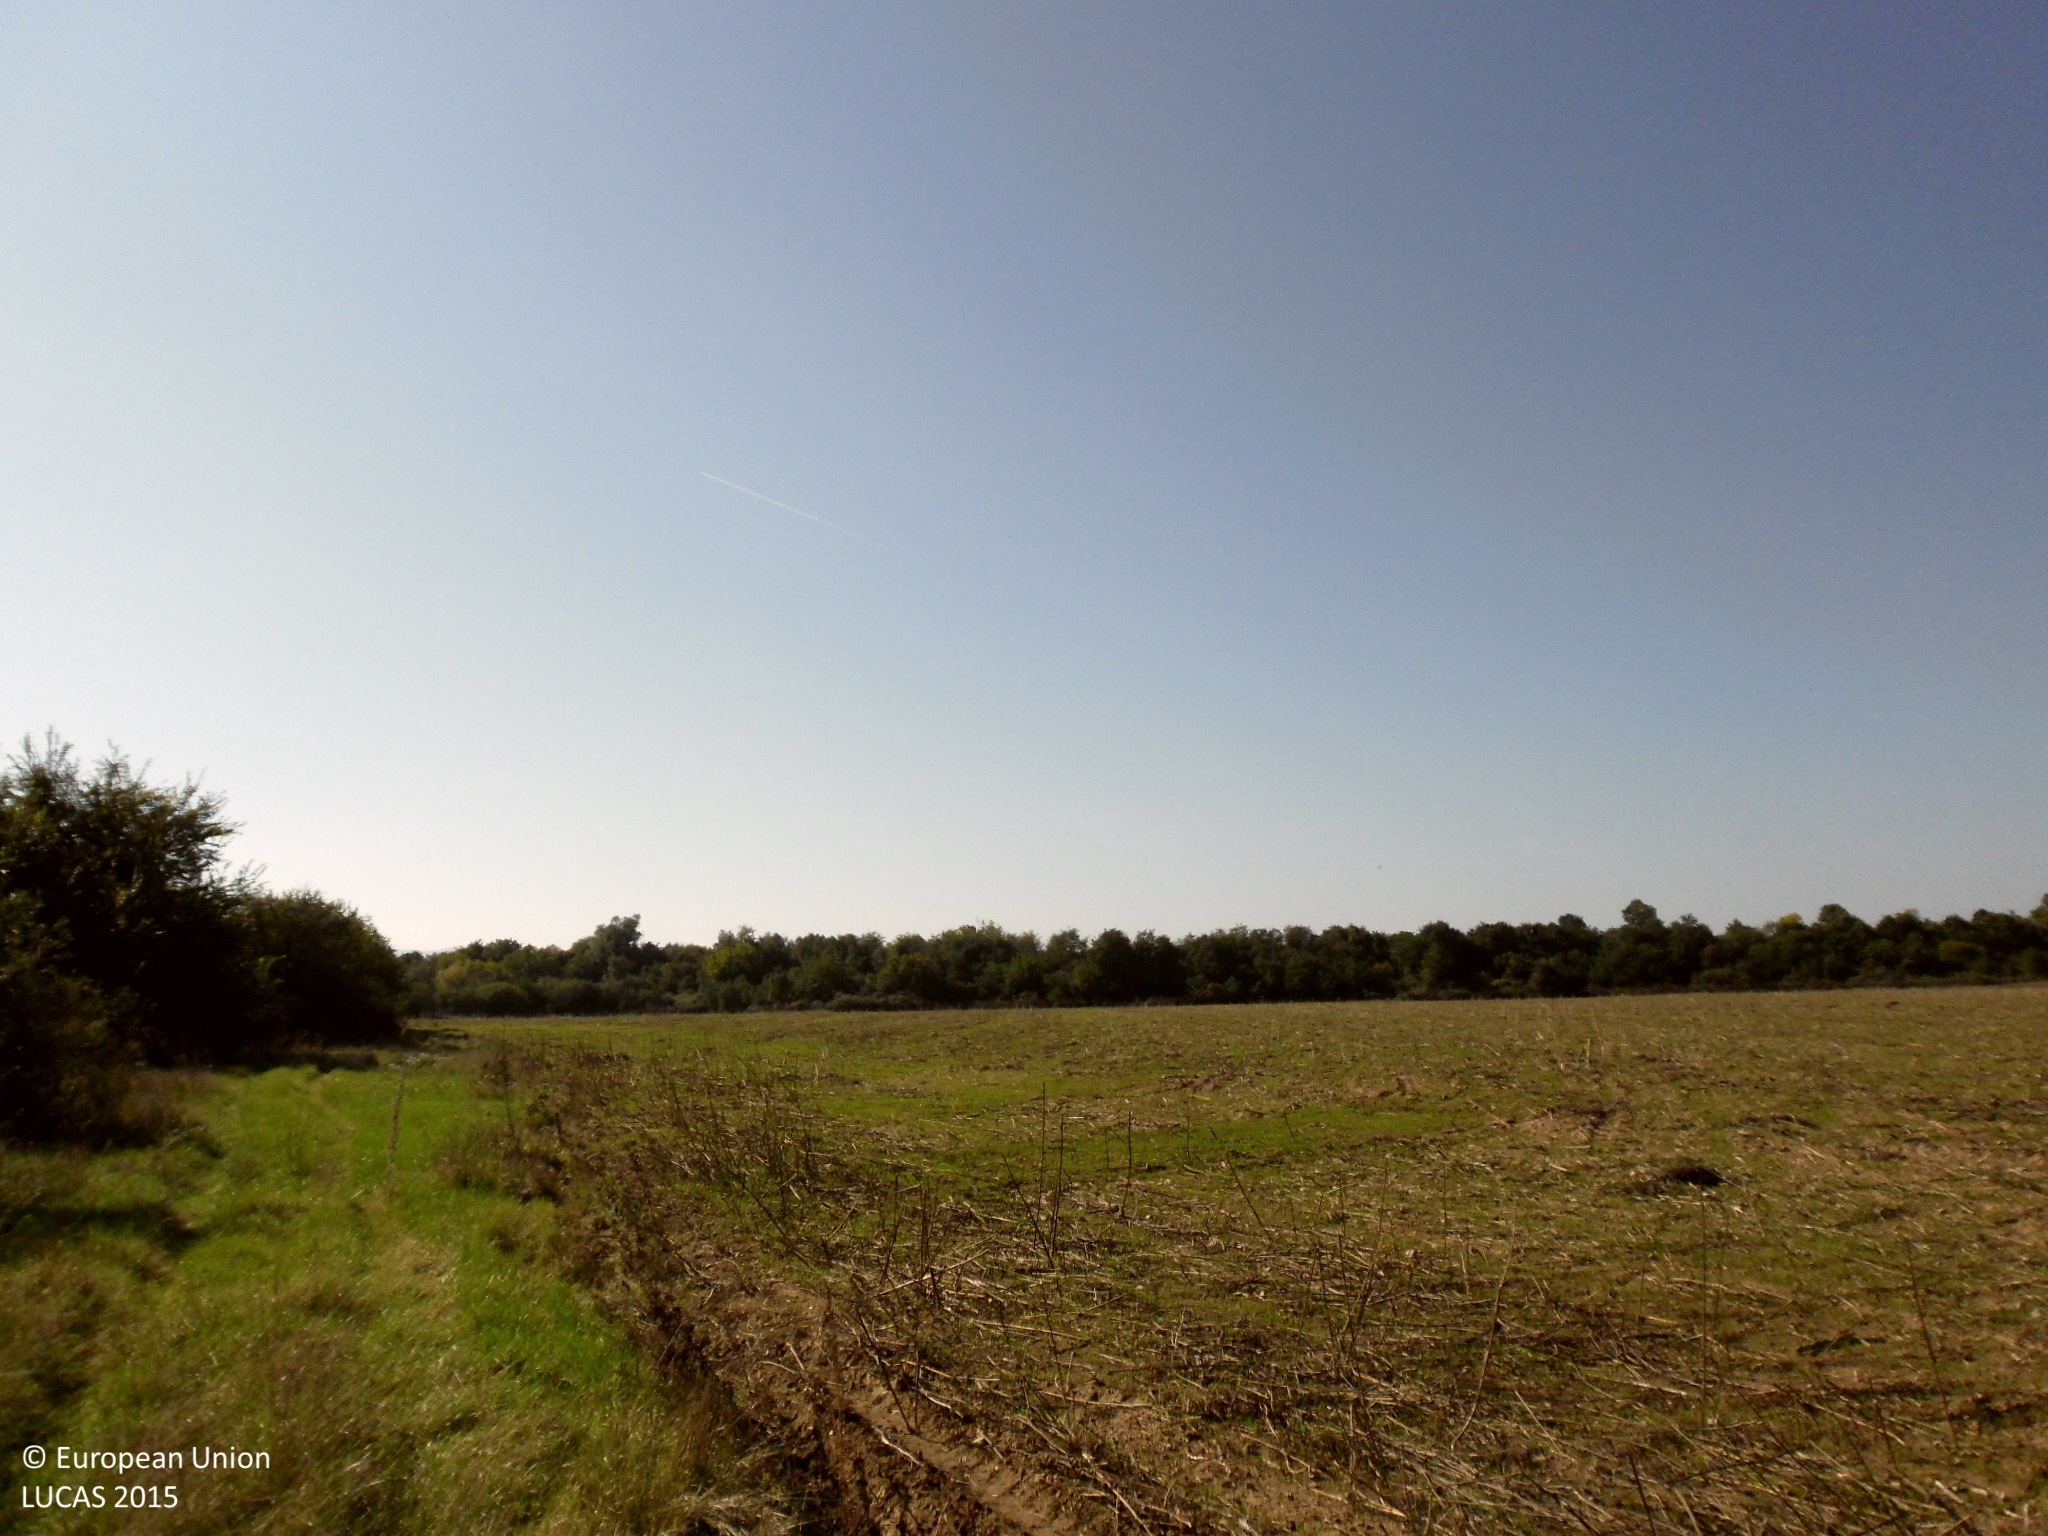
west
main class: Shrubland
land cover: Shrubland with sparse tree cover
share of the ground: > 75 %
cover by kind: shrubs 95 %, broadleaved forest trees 5 %
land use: Semi-natural and natural areas not in use
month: October
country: BG
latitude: 43.6664
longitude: 22.9228
